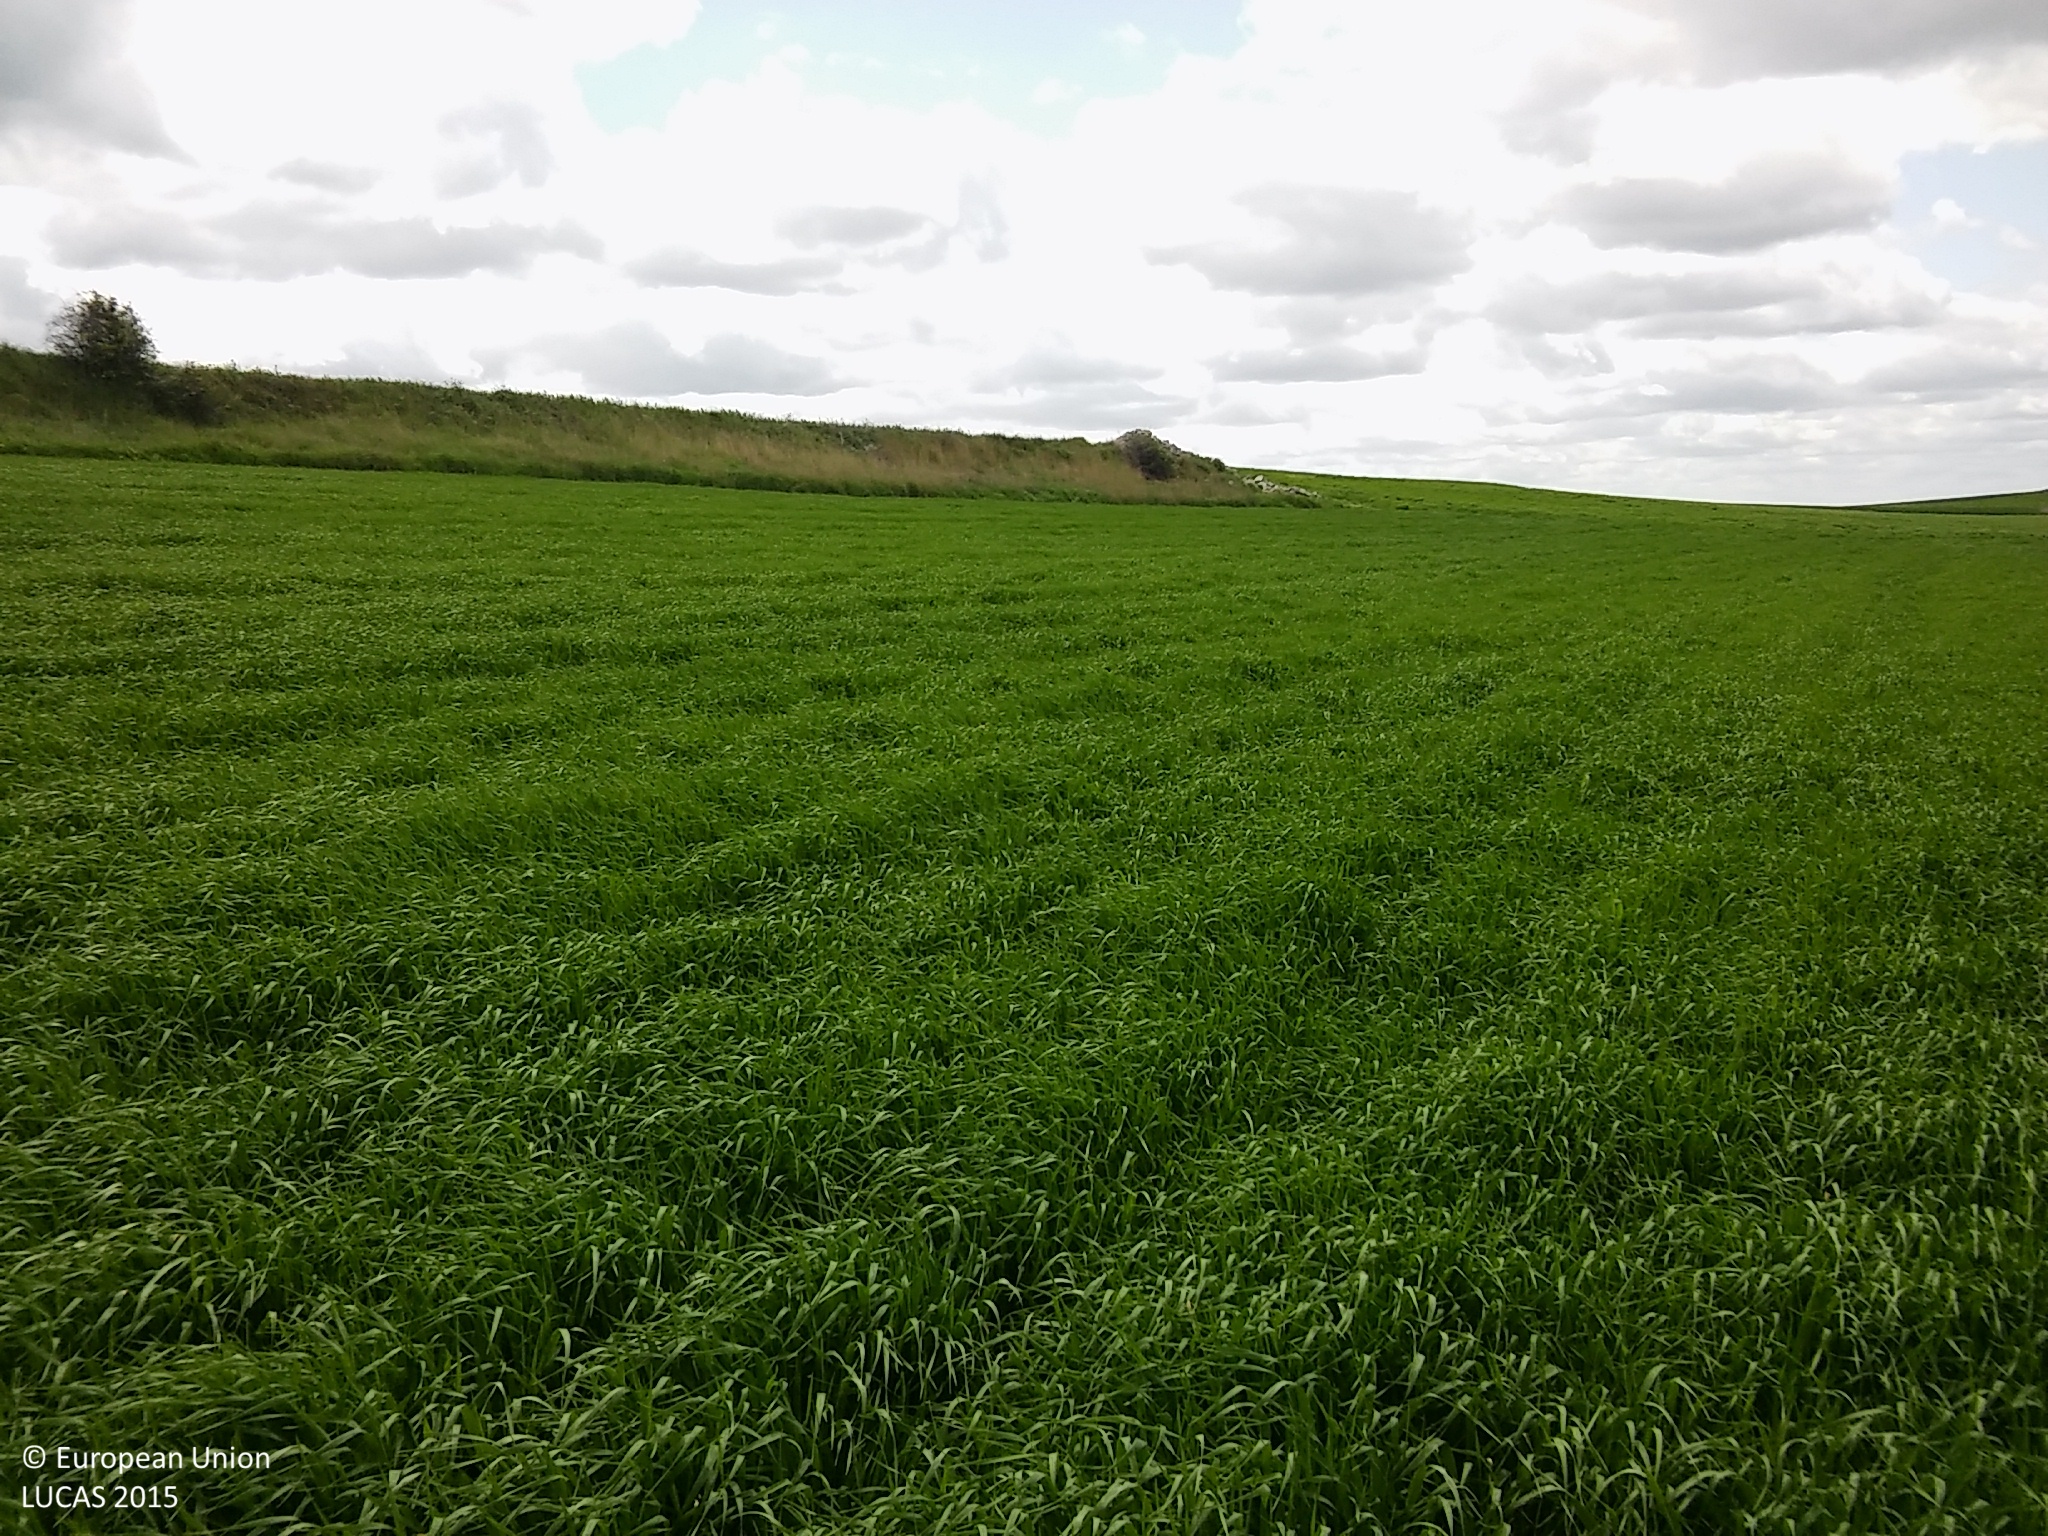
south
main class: Cropland
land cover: Barley
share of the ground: > 75 %
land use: Agriculture (excluding fallow land and kitchen gardens)
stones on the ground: < 10 %
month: May
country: ES
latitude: 41.3931
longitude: -4.0600
